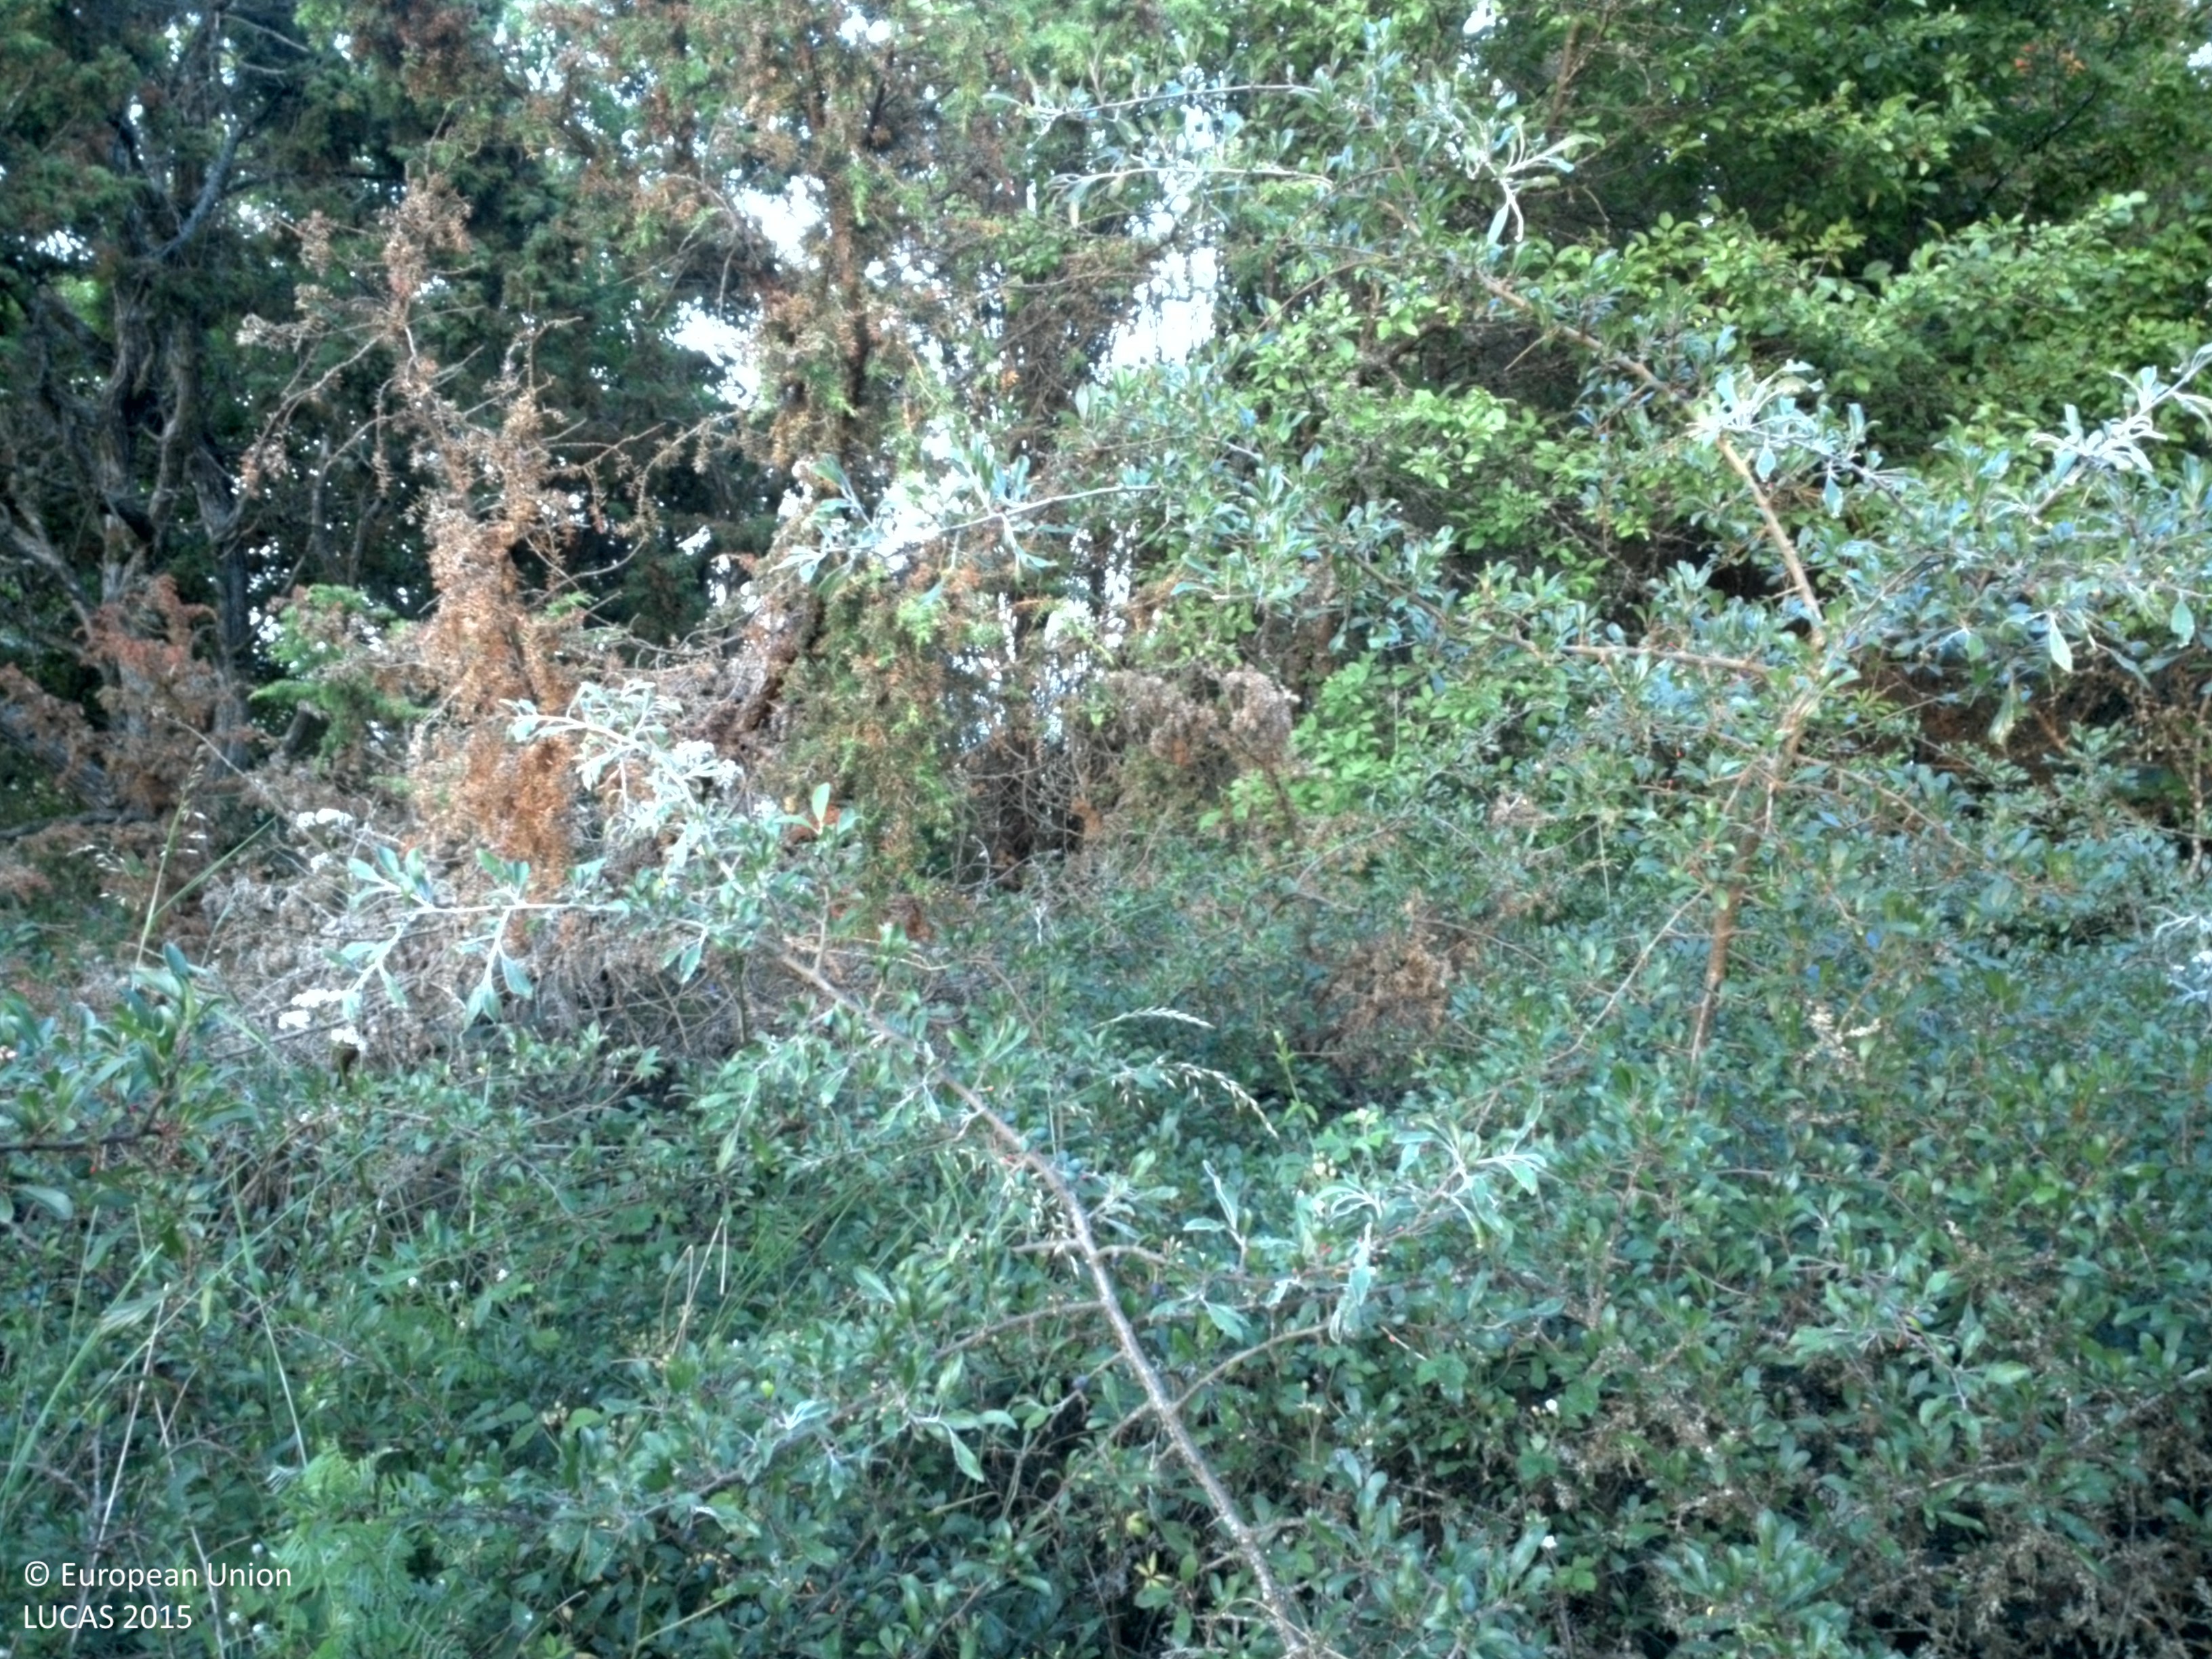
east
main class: Shrubland
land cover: Shrubland with sparse tree cover
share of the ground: > 75 %
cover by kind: shrubs 95 %, broadleaved forest trees 5 %
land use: Amenities, museums, leisure
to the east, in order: Shrubland with sparse tree cover; Tracks; Grass margins; Rocks and stones
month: July
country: SE
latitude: 57.6427
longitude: 18.7716
